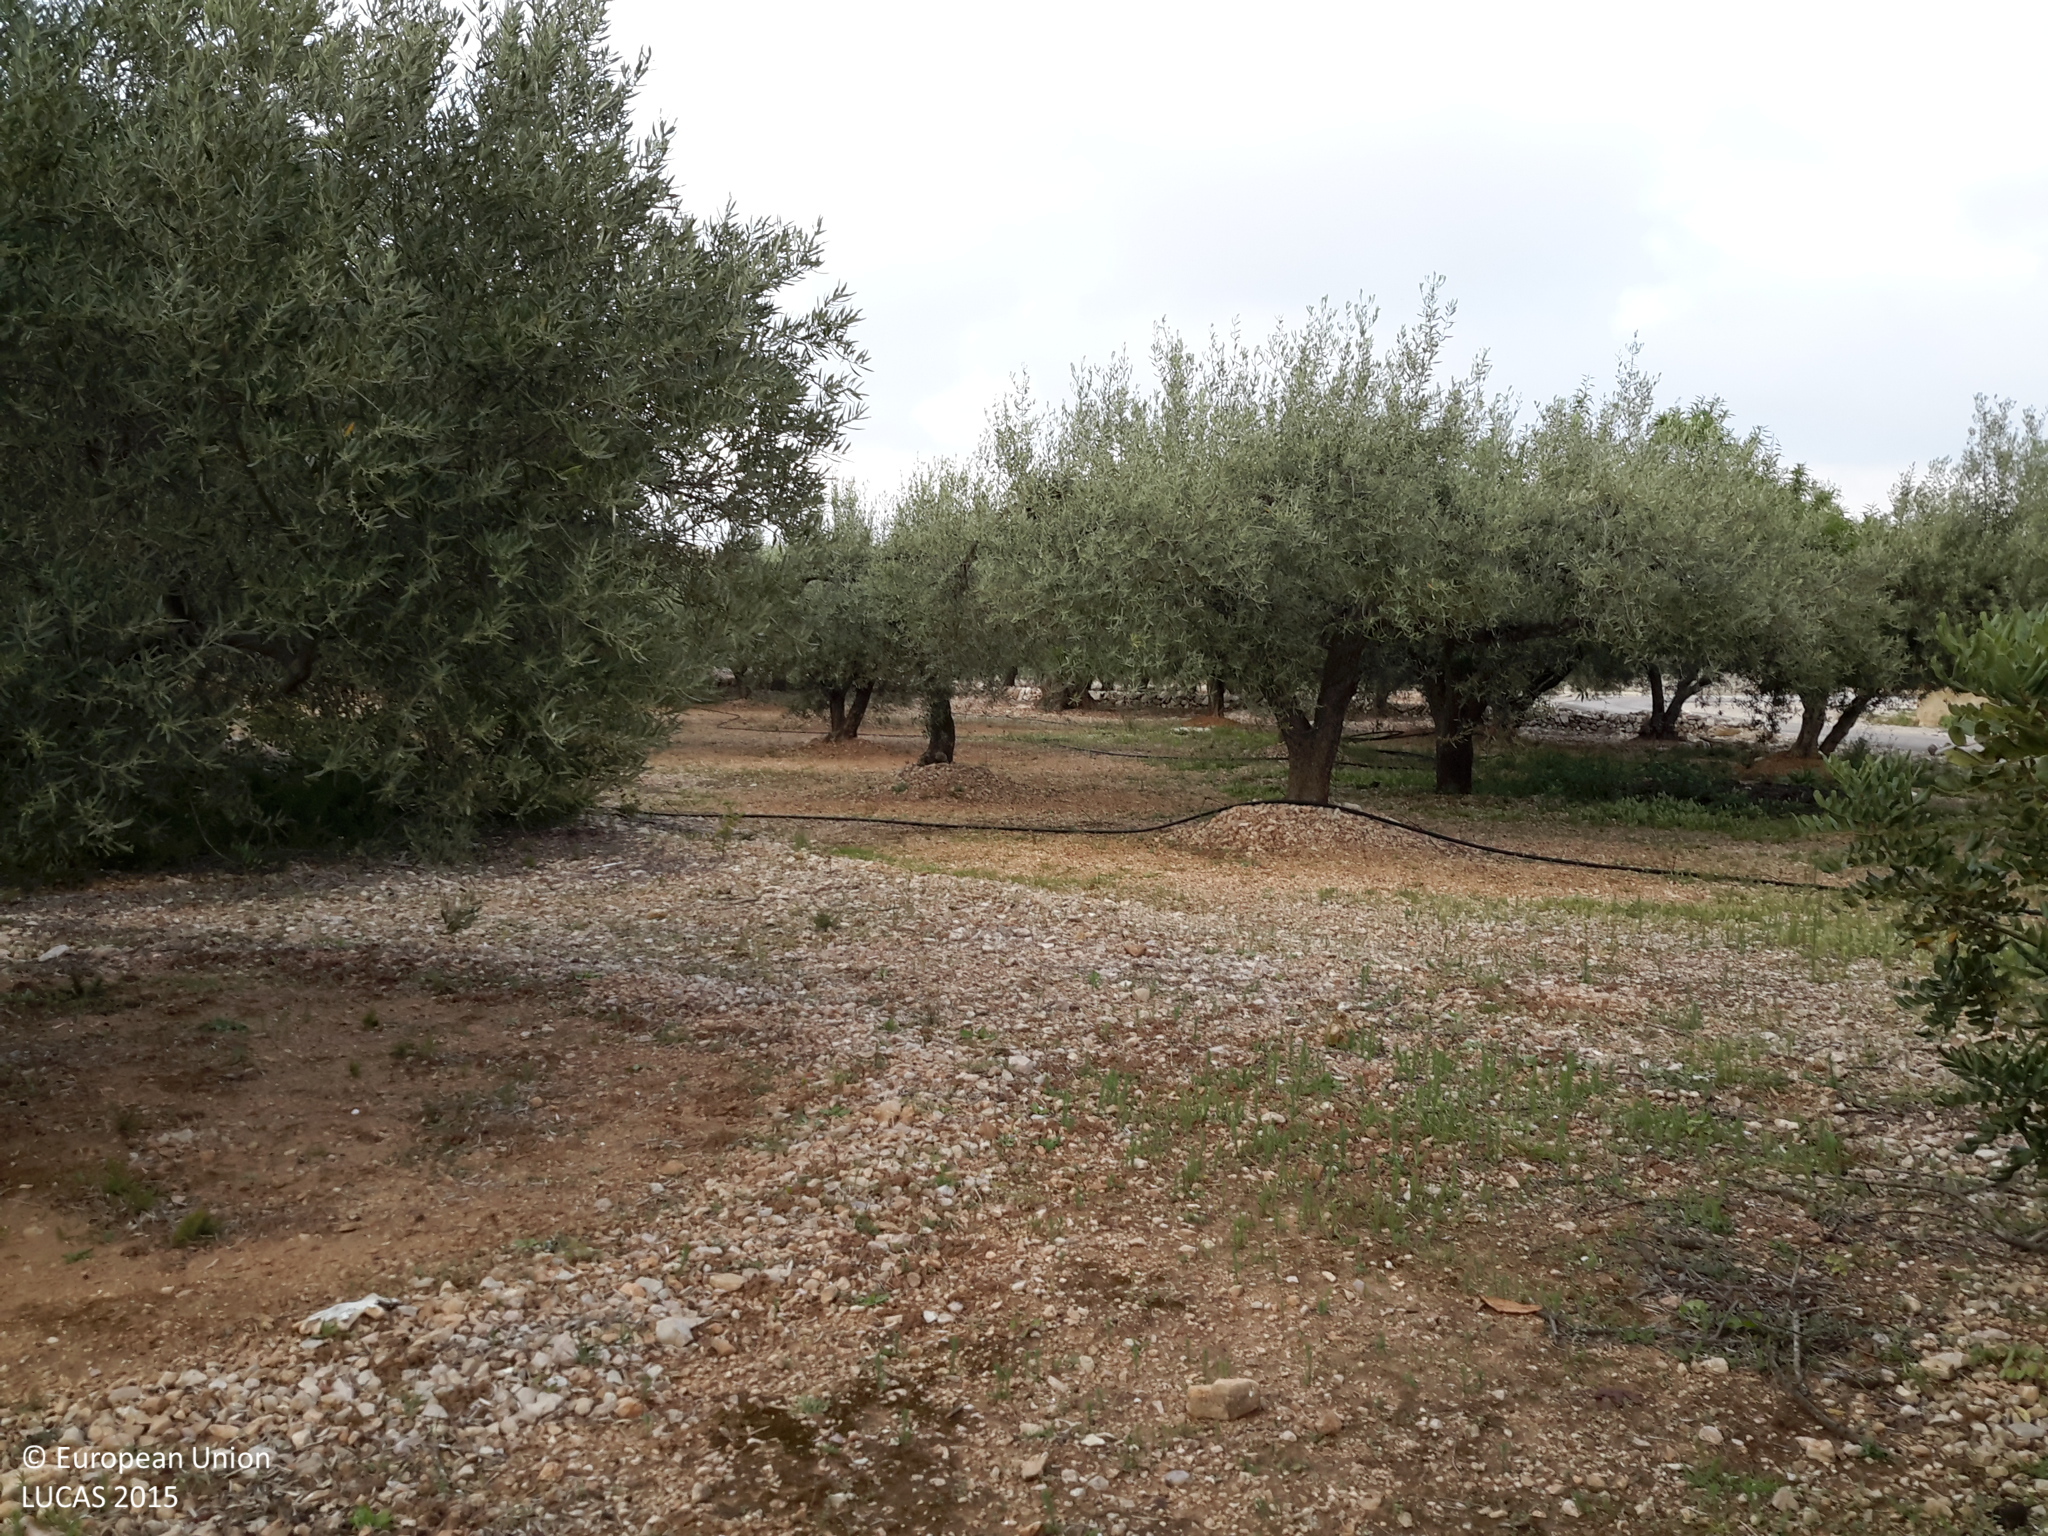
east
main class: Cropland
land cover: Olive groves
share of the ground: 25 - 50 %
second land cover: Spontaneously vegetated surfaces
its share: 25 - 50 %
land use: Agriculture (excluding fallow land and kitchen gardens)
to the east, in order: Olive groves; Spontaneously vegetated surfaces; Paved roads, cycling and walking lanes; Olive groves; Electric lines; Olive groves; Shrubland with sparse tree cover; Tracks; Grassland with sparse tree/shrub cover; Olive groves; Dry stone walls; Olive groves; Electric lines; Olive groves; Paved roads, cycling and walking lanes; Olive groves; Dry stone walls; Permanent industrial crops; Dry stone walls; Olive groves; Dry stone walls; Olive groves
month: April
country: ES
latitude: 40.6315
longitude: 0.5727
